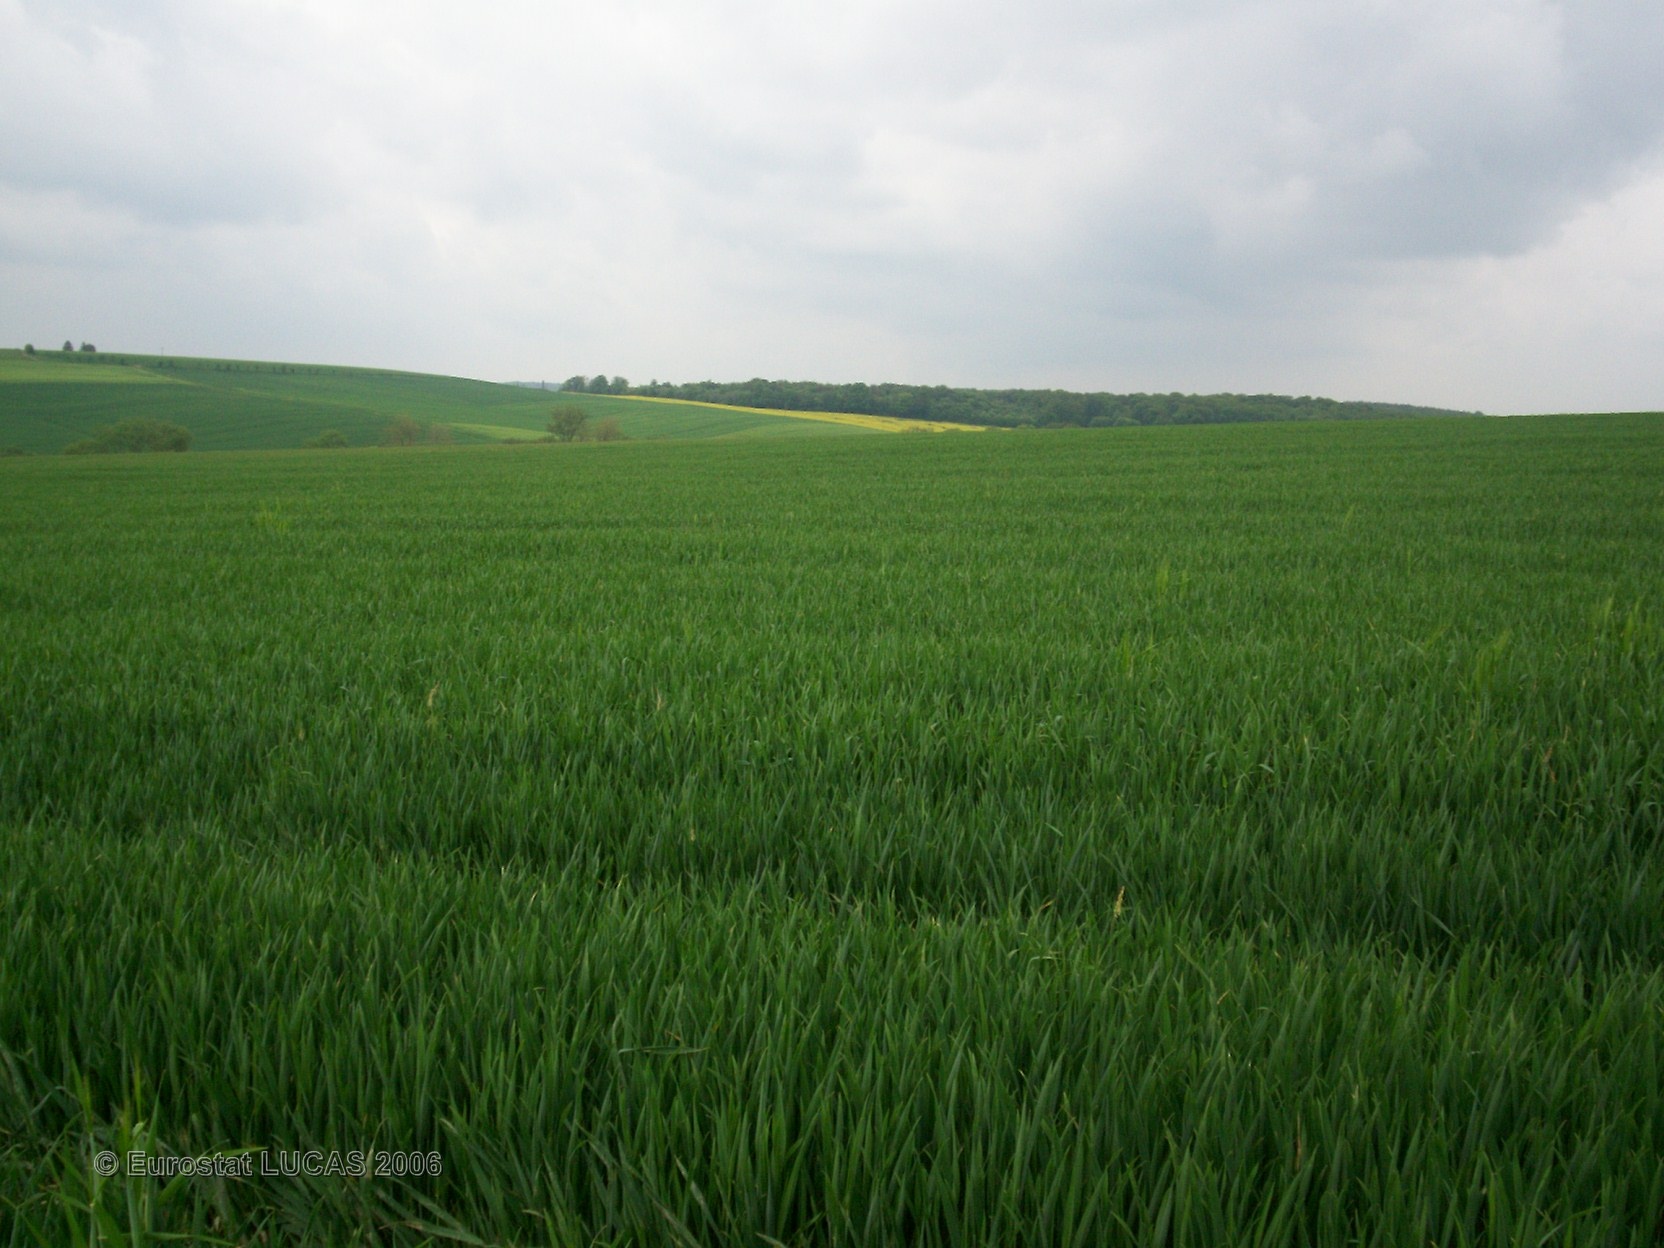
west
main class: Cropland
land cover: Common wheat
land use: Agriculture (excluding fallow land and kitchen gardens)
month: May
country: FR
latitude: 49.3929
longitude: 6.5141
